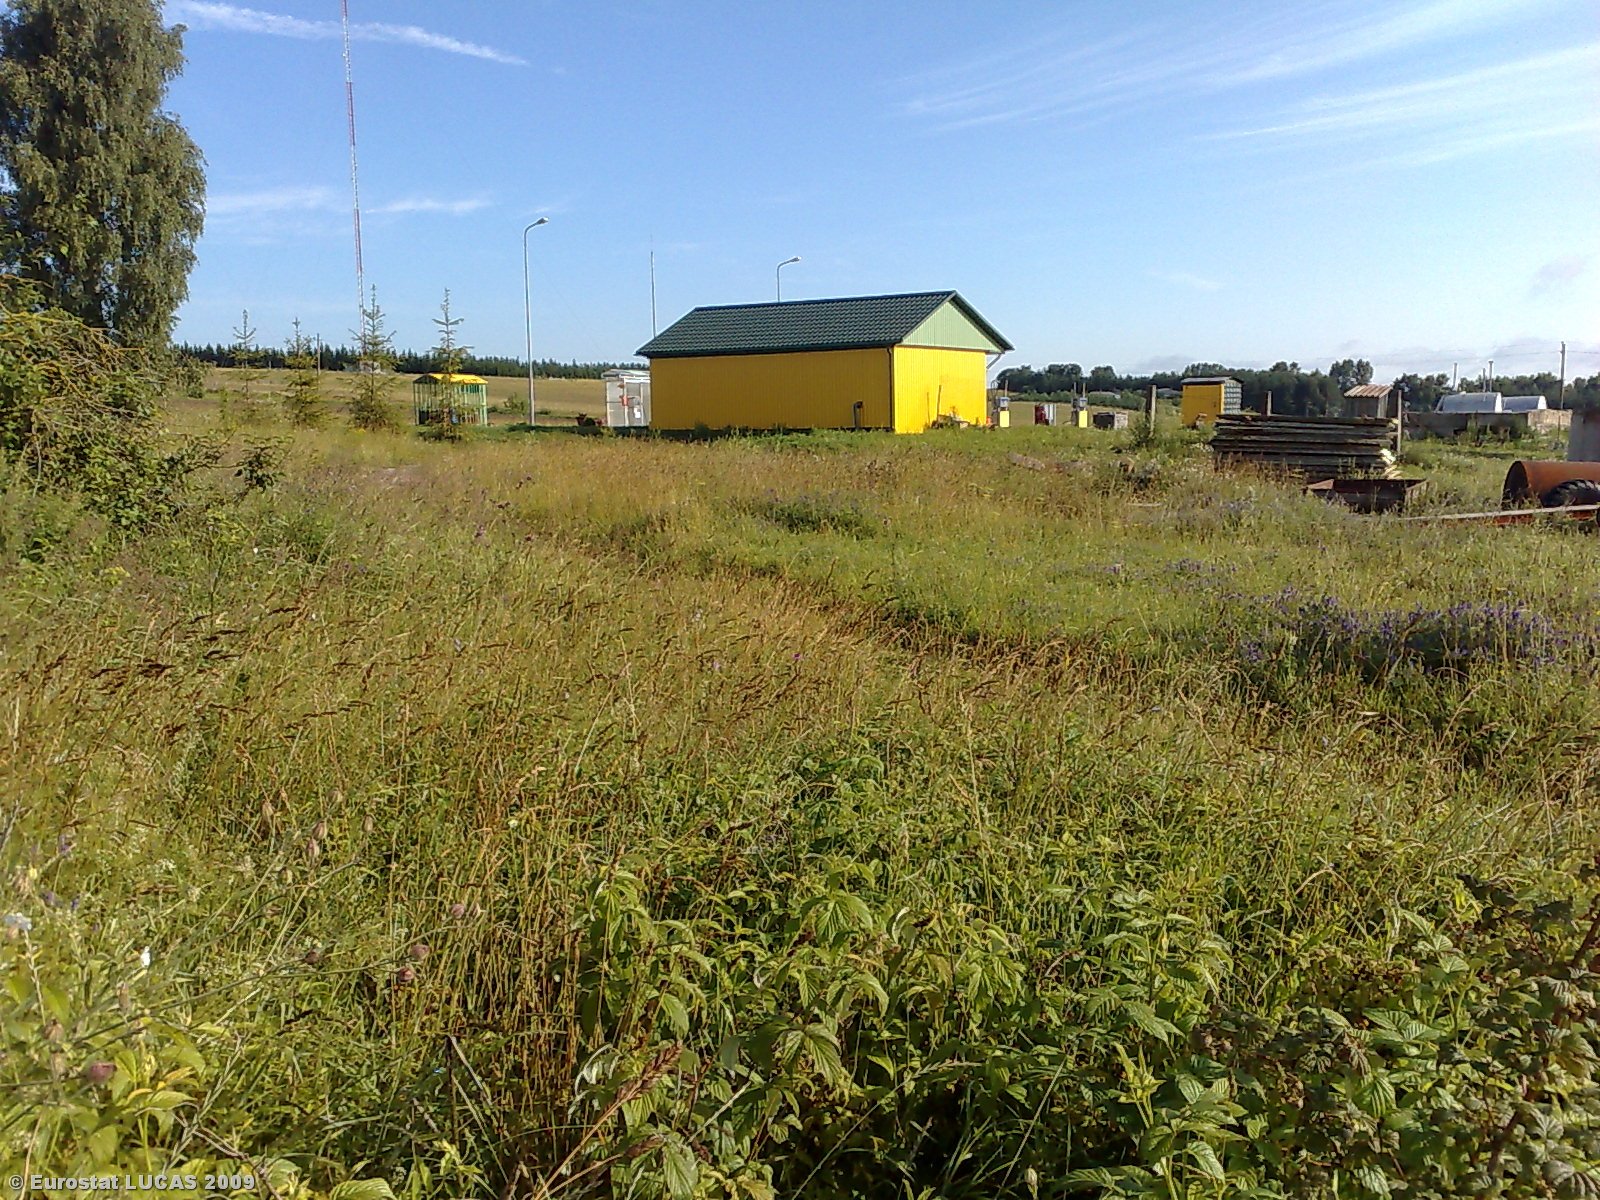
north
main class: Grassland
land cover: Grassland without tree/shrub cover
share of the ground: > 75 %
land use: Agriculture (excluding fallow land and kitchen gardens)
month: July
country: LT
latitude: 55.8296
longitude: 22.8534
